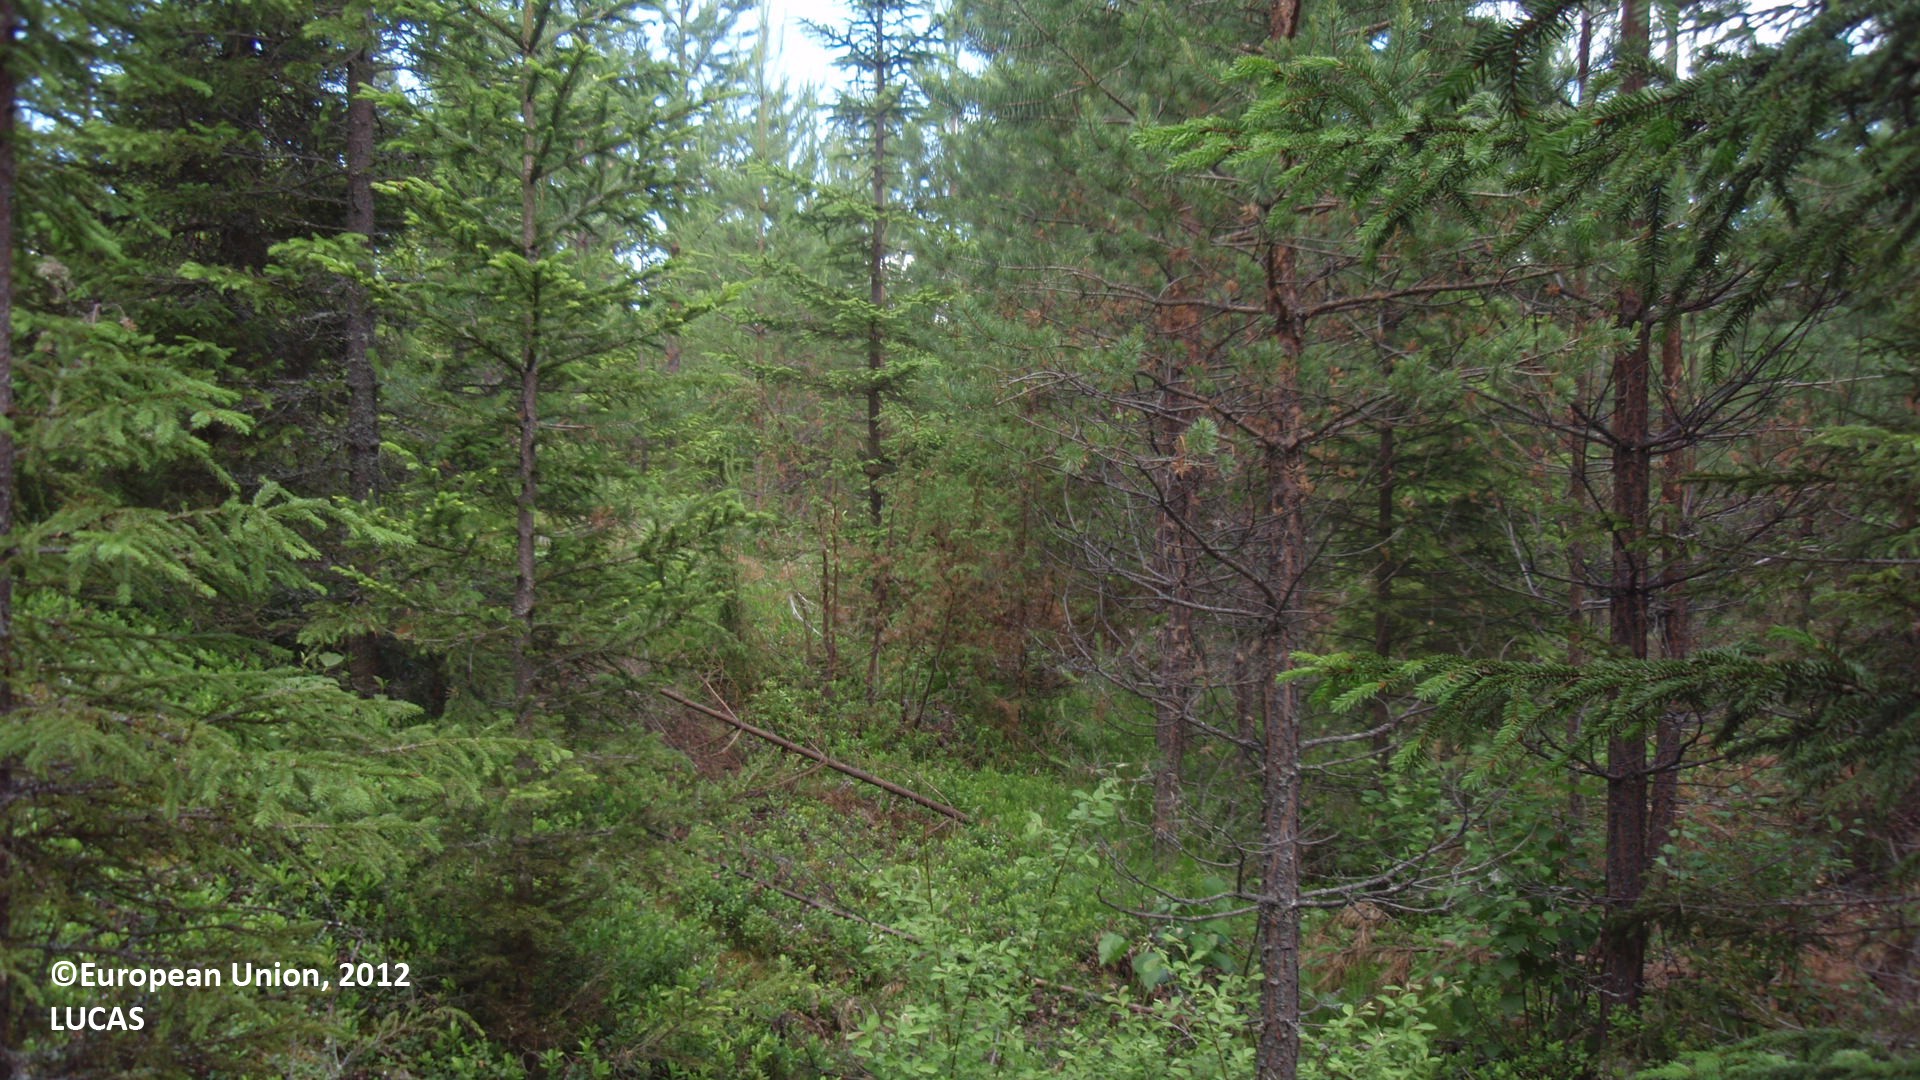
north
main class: Woodland
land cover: Spruce dominated coniferous woodland
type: boreal forest
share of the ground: 50 - 75 %
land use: Forestry
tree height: < 5 m
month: July
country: FI
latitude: 61.6692
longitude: 28.0836
